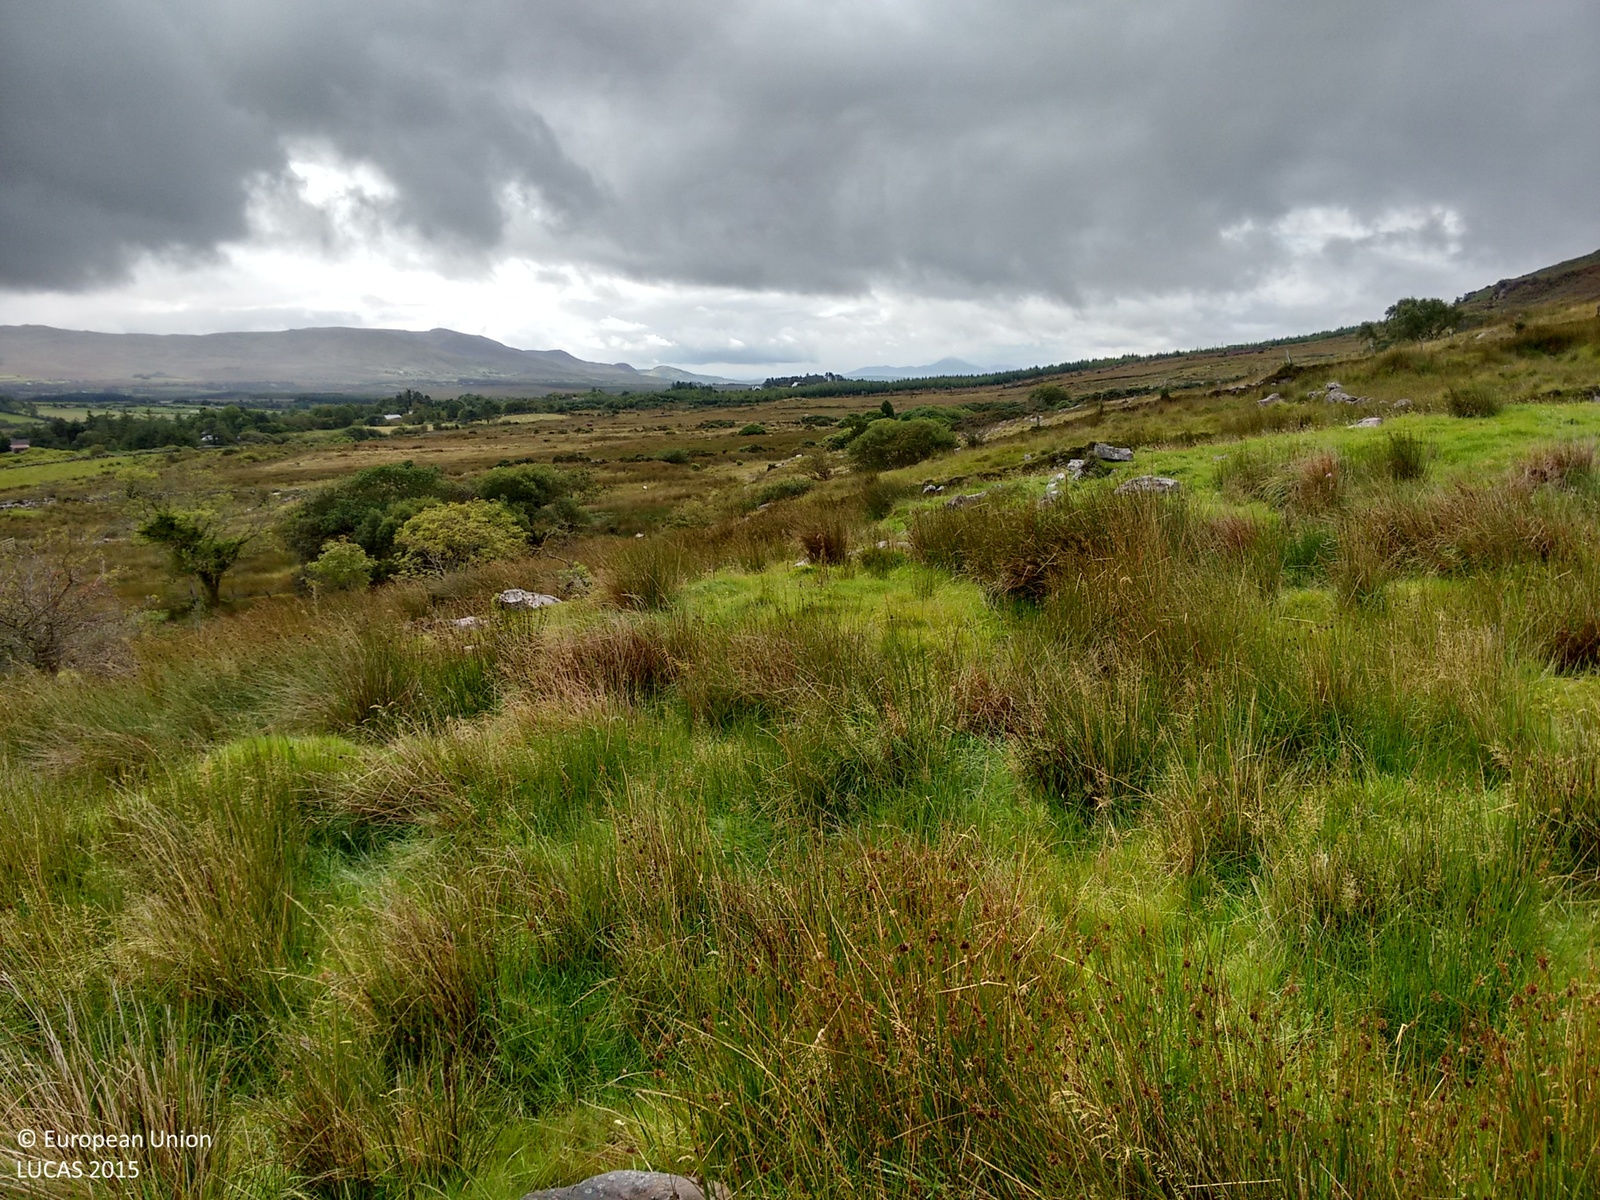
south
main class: Shrubland
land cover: Shrubland without tree cover
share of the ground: > 75 %
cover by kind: shrubs 60 %, lichens and mosses 30 %, herbaceous plants 10 %
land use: Agriculture (excluding fallow land and kitchen gardens)
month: September
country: IE
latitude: 54.0064
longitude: -9.3436
